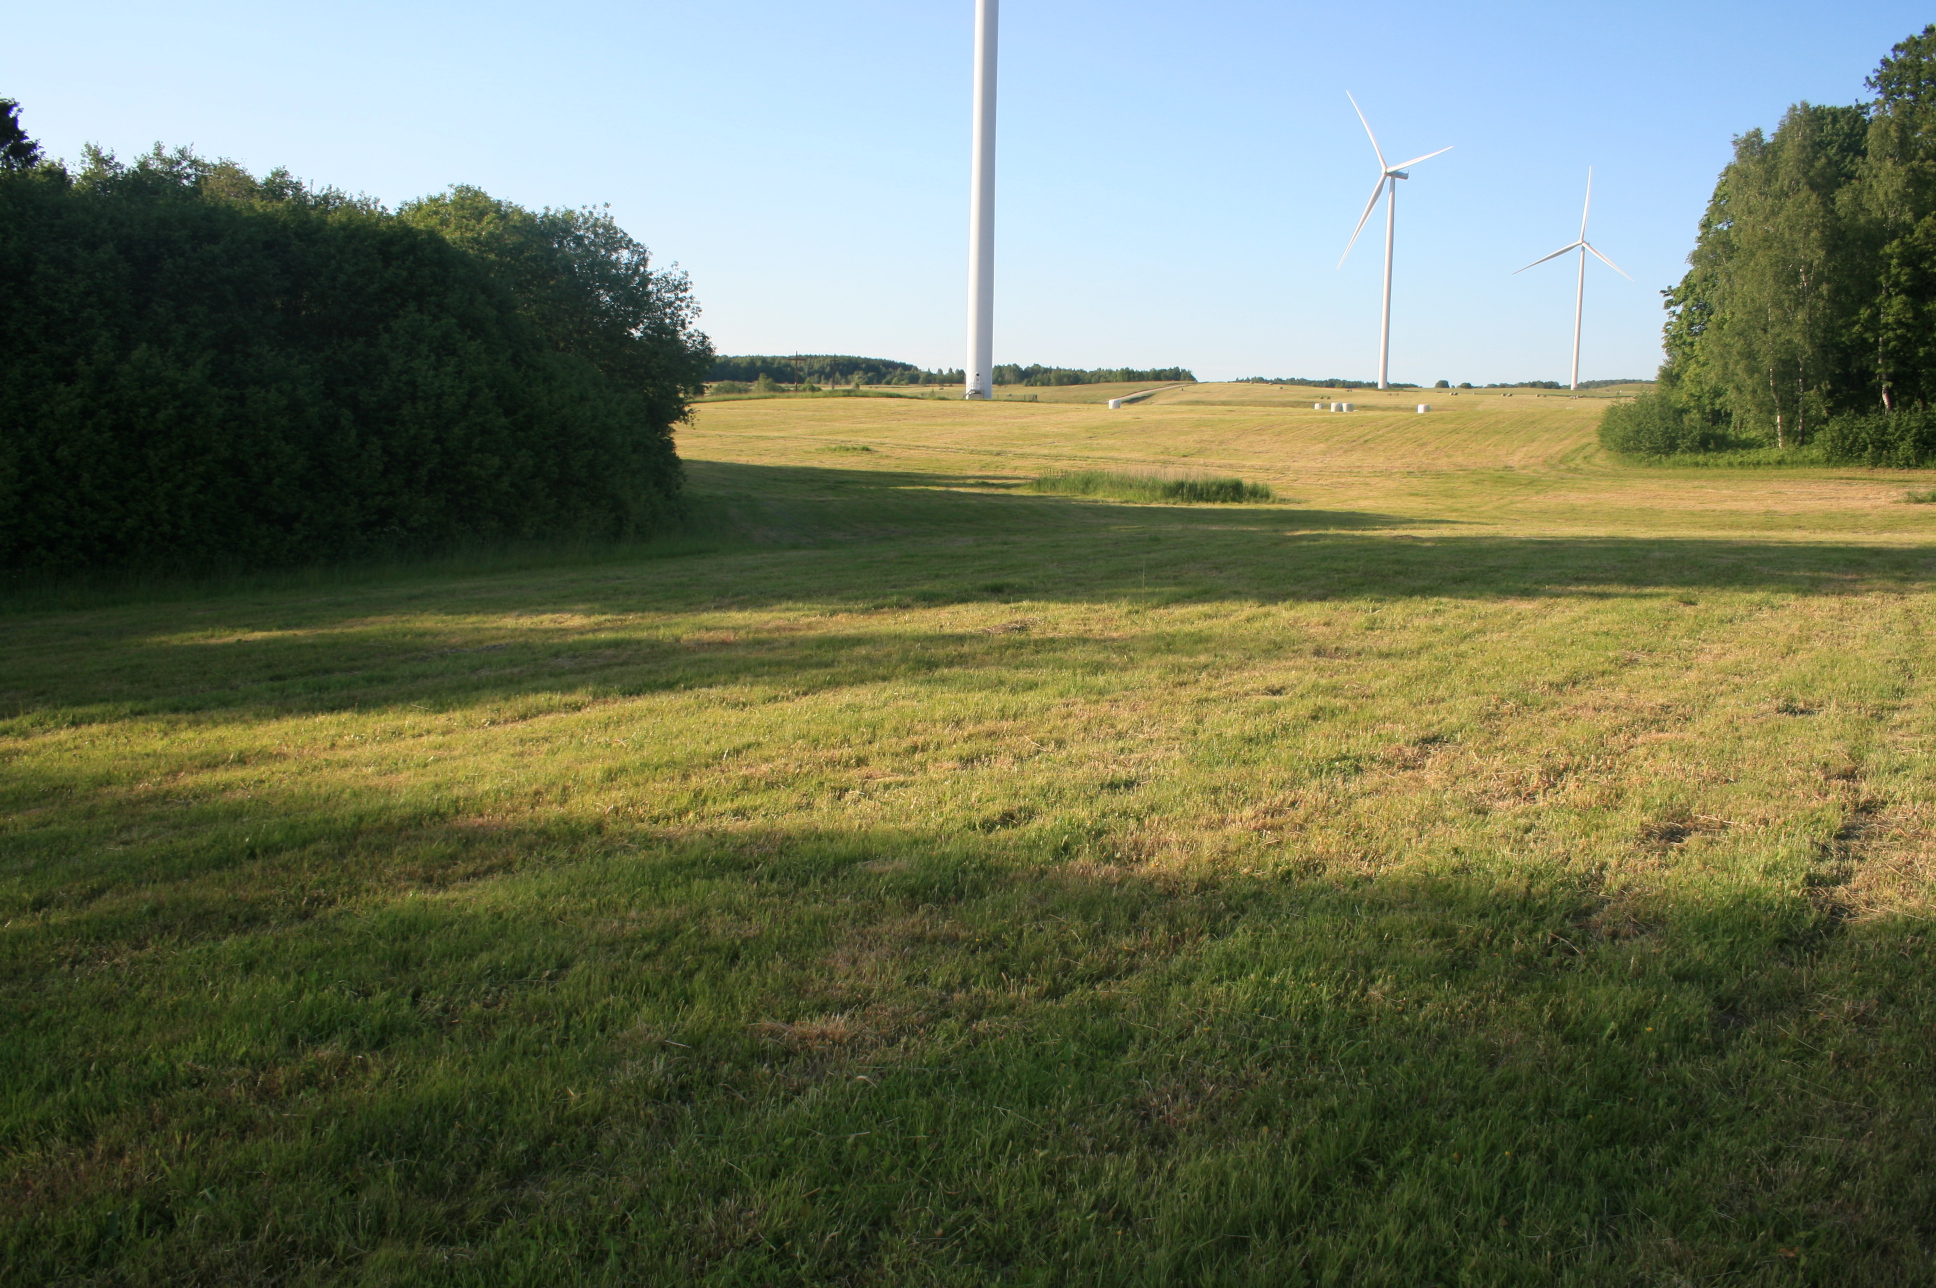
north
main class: Grassland
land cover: Grassland without tree/shrub cover
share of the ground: > 75 %
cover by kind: herbaceous plants 100 %
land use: Agriculture (excluding fallow land and kitchen gardens)
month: June
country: LT
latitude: 55.5678
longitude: 22.1871
